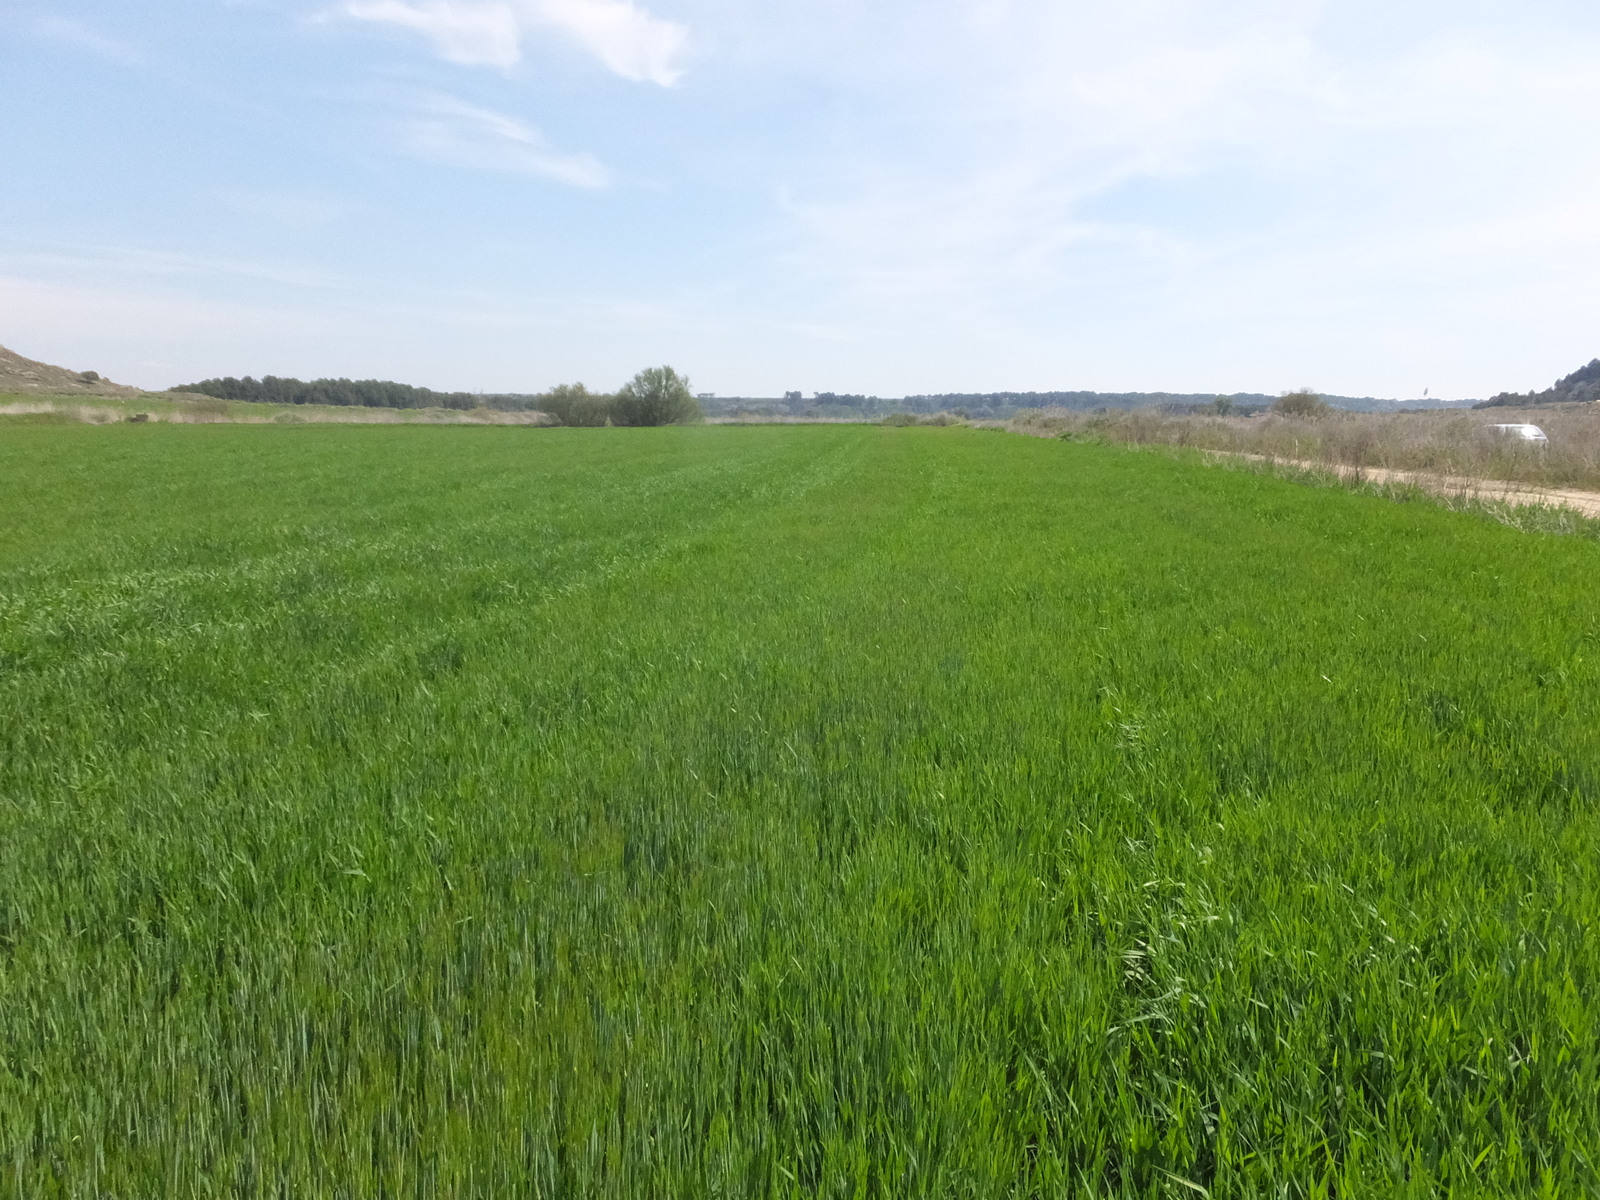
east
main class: Cropland
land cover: Durum wheat
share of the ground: > 75 %
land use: Agriculture (excluding fallow land and kitchen gardens)
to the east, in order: Durum wheat; Grass margins; Ditches and canals; Grass margins; Durum wheat
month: April
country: ES
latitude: 41.7732
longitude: -0.2077
